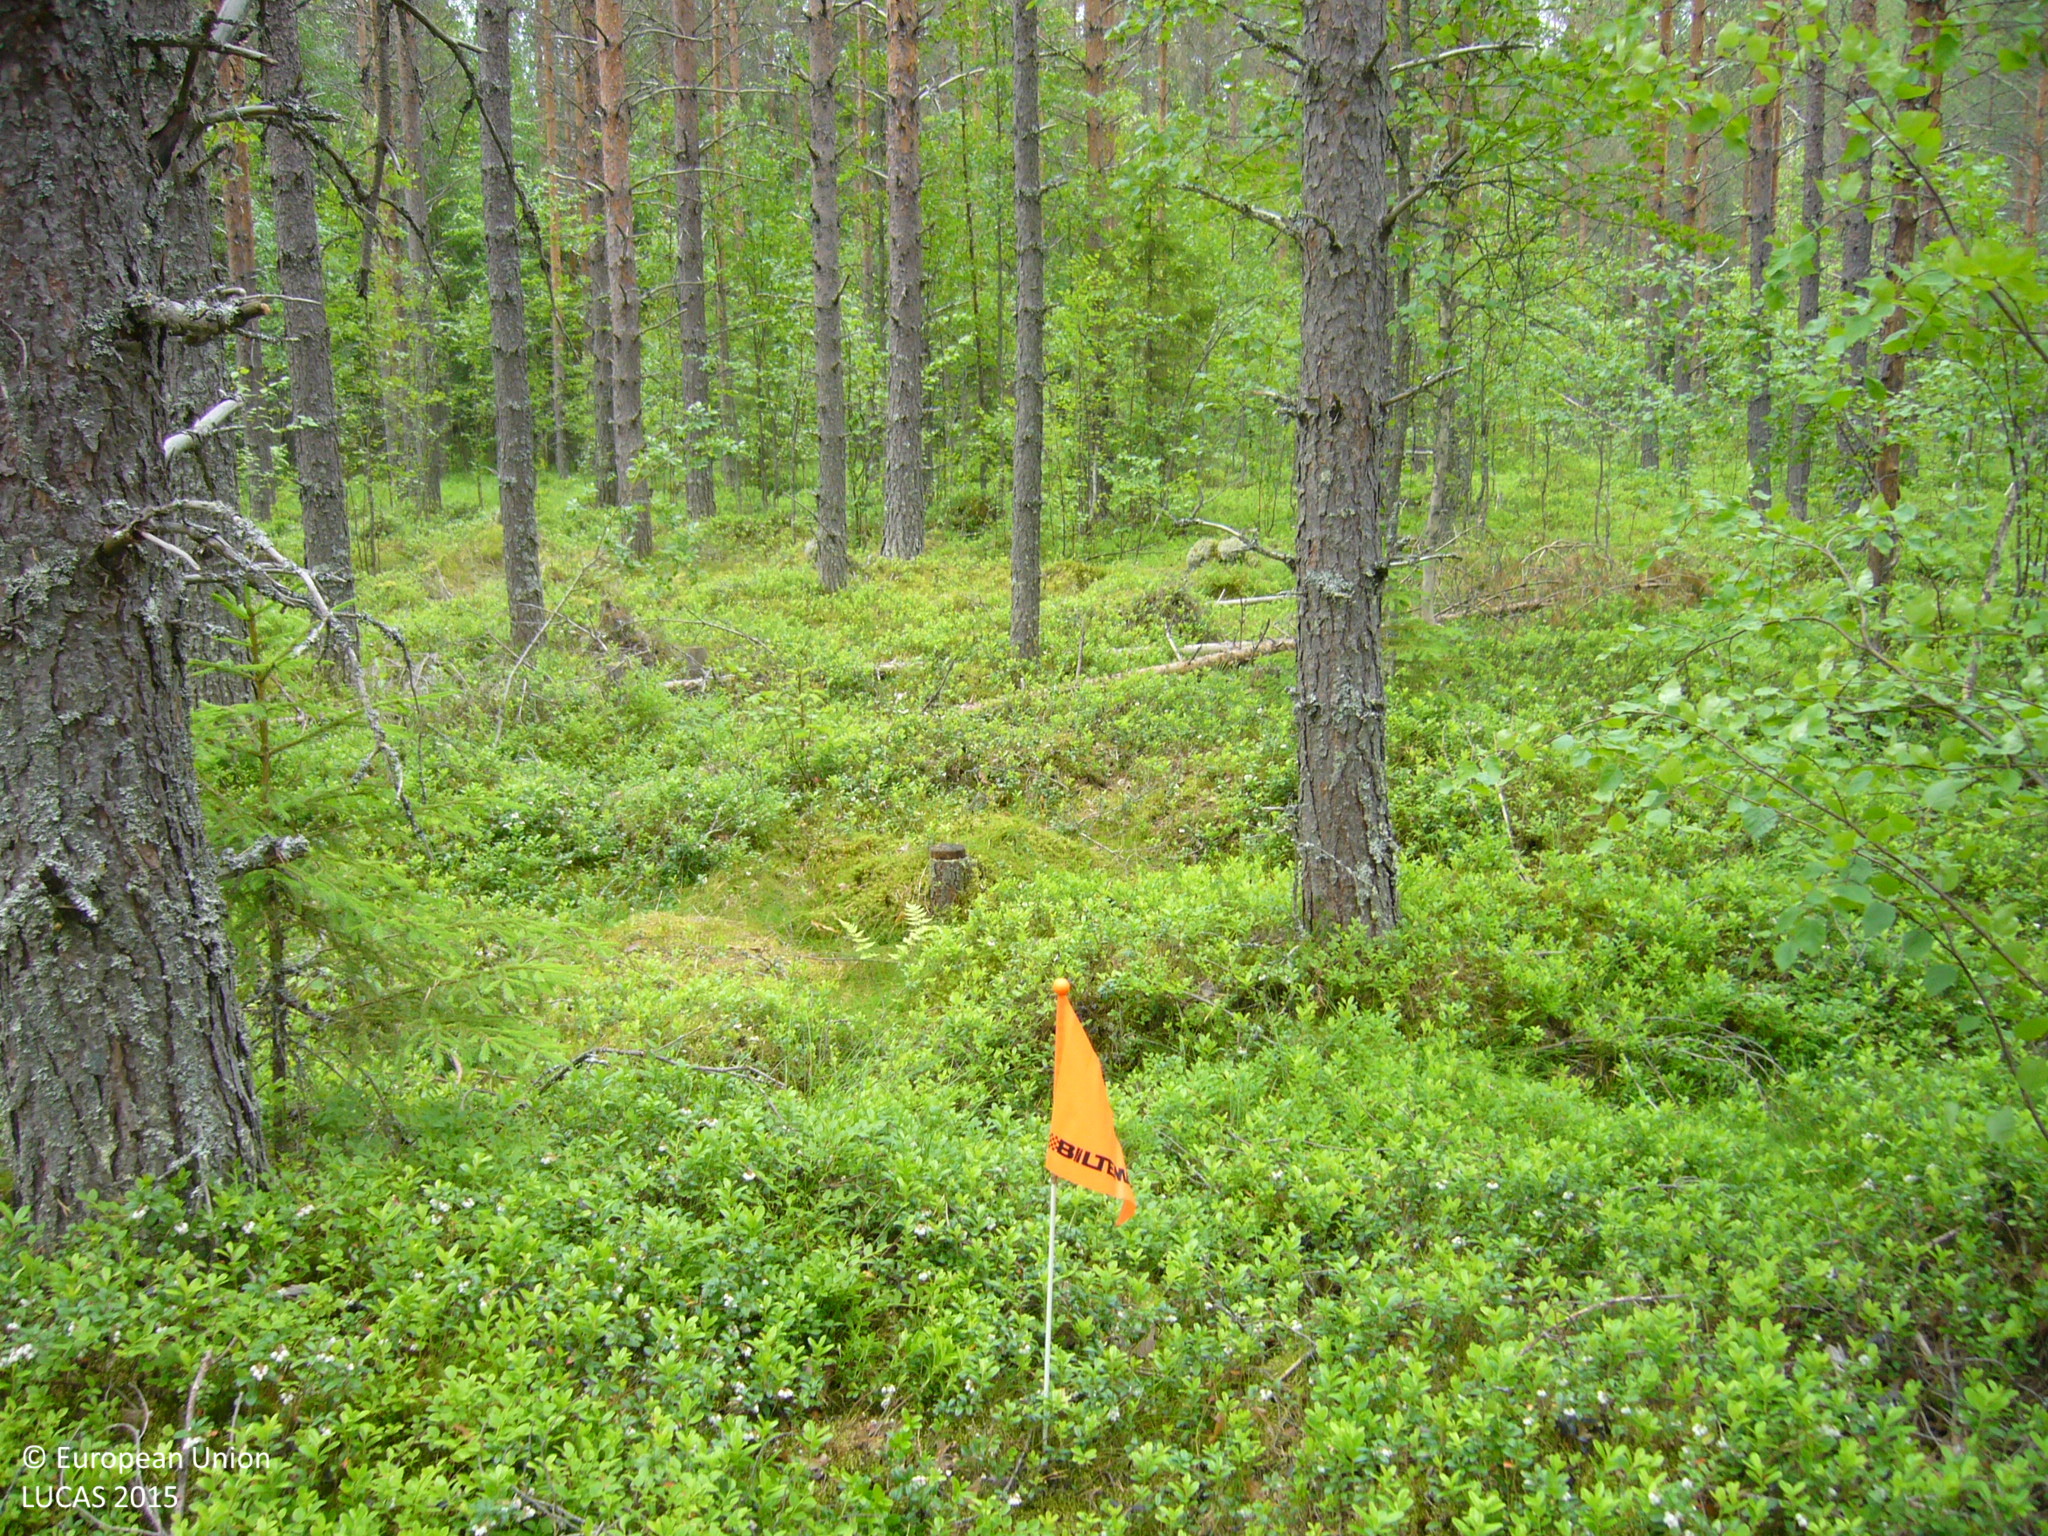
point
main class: Woodland
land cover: Pine dominated mixed woodland
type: boreal forest
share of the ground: 50 - 75 %
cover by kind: coniferous forest trees 50 %, shrubs 30 %, broadleaved forest trees 20 %
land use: Forestry
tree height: > 5 m
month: July
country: FI
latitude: 63.3126
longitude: 26.0631
